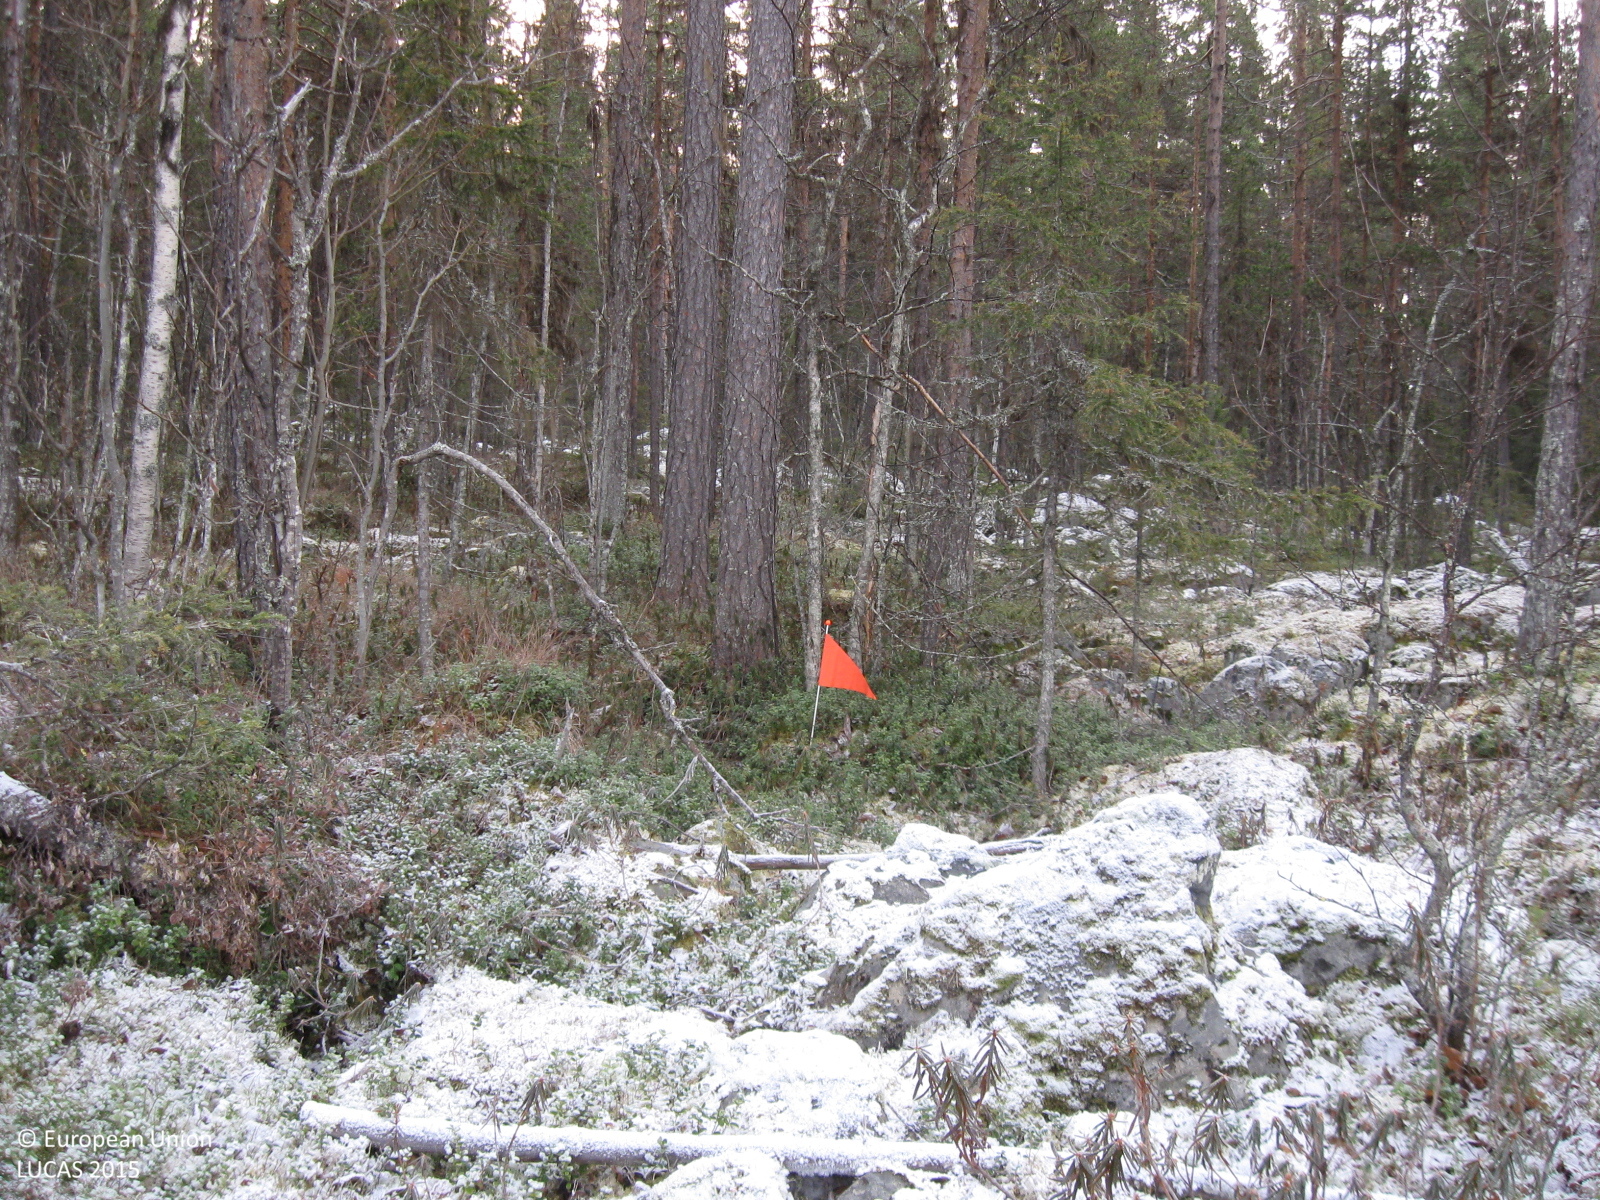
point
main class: Woodland
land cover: Pine dominated mixed woodland
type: boreal forest
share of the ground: 50 - 75 %
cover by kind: coniferous forest trees 45 %, broadleaved forest trees 25 %, unconsolidated bare surface 15 %, shrubs 5 %, herbaceous plants 5 %, lichens and mosses 5 %
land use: Forestry
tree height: > 5 m
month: October
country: SE
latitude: 66.2213
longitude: 21.6357
